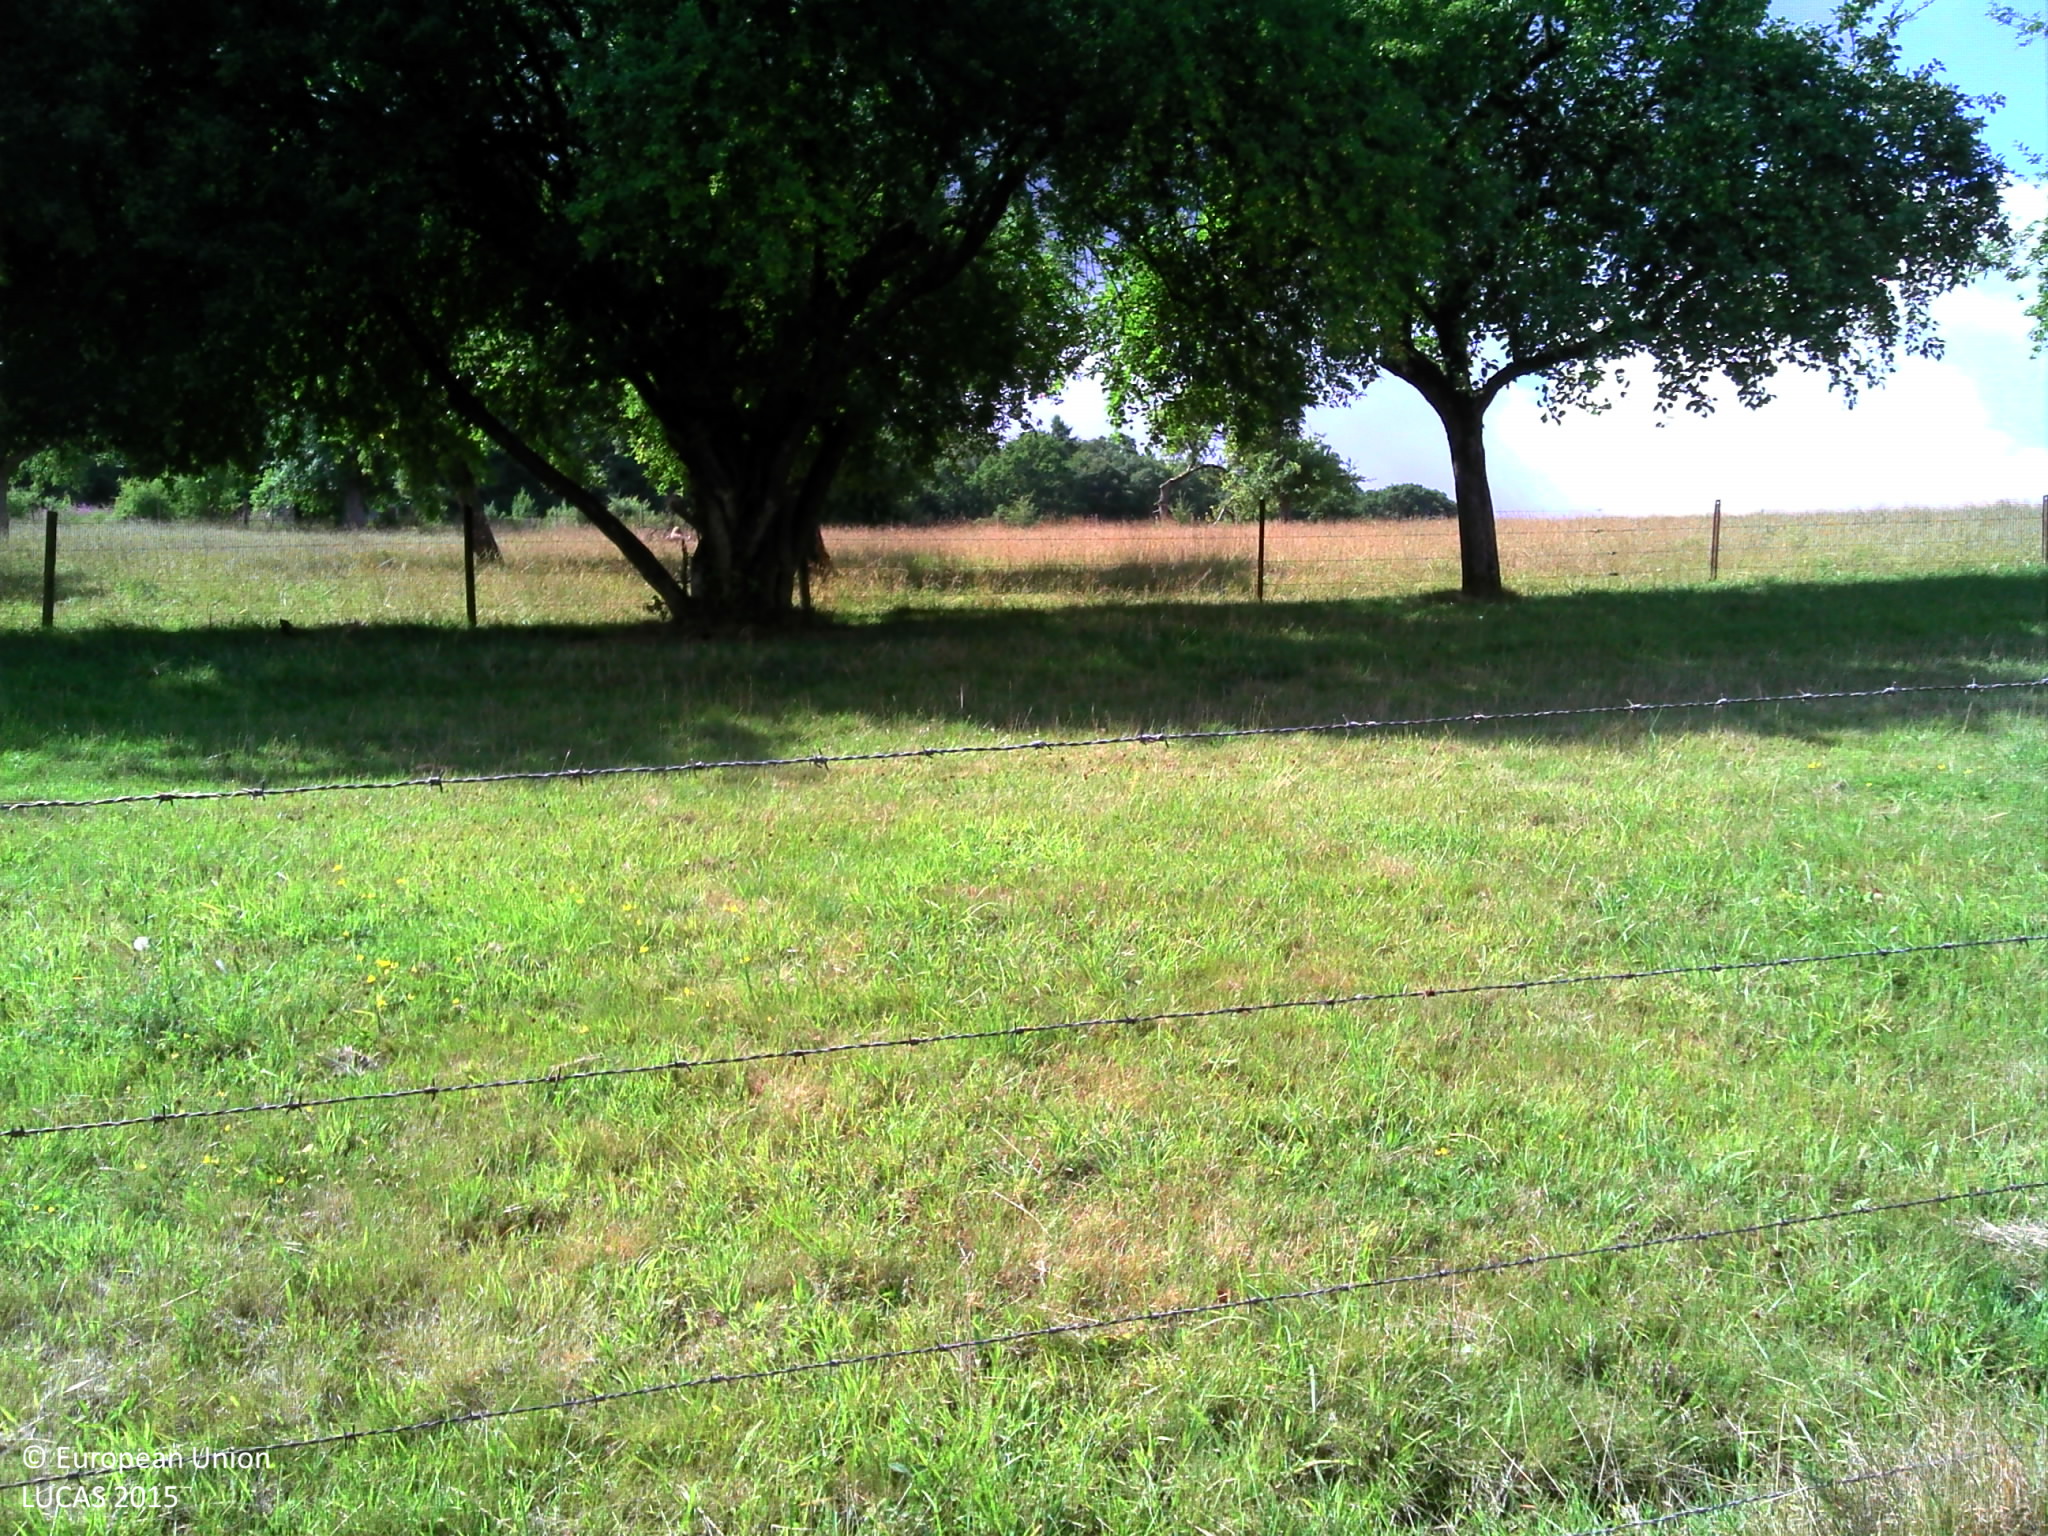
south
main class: Grassland
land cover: Grassland without tree/shrub cover
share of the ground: > 75 %
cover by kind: herbaceous plants 100 %
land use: Agriculture (excluding fallow land and kitchen gardens)
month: July
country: BE
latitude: 49.5765
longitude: 5.5870
